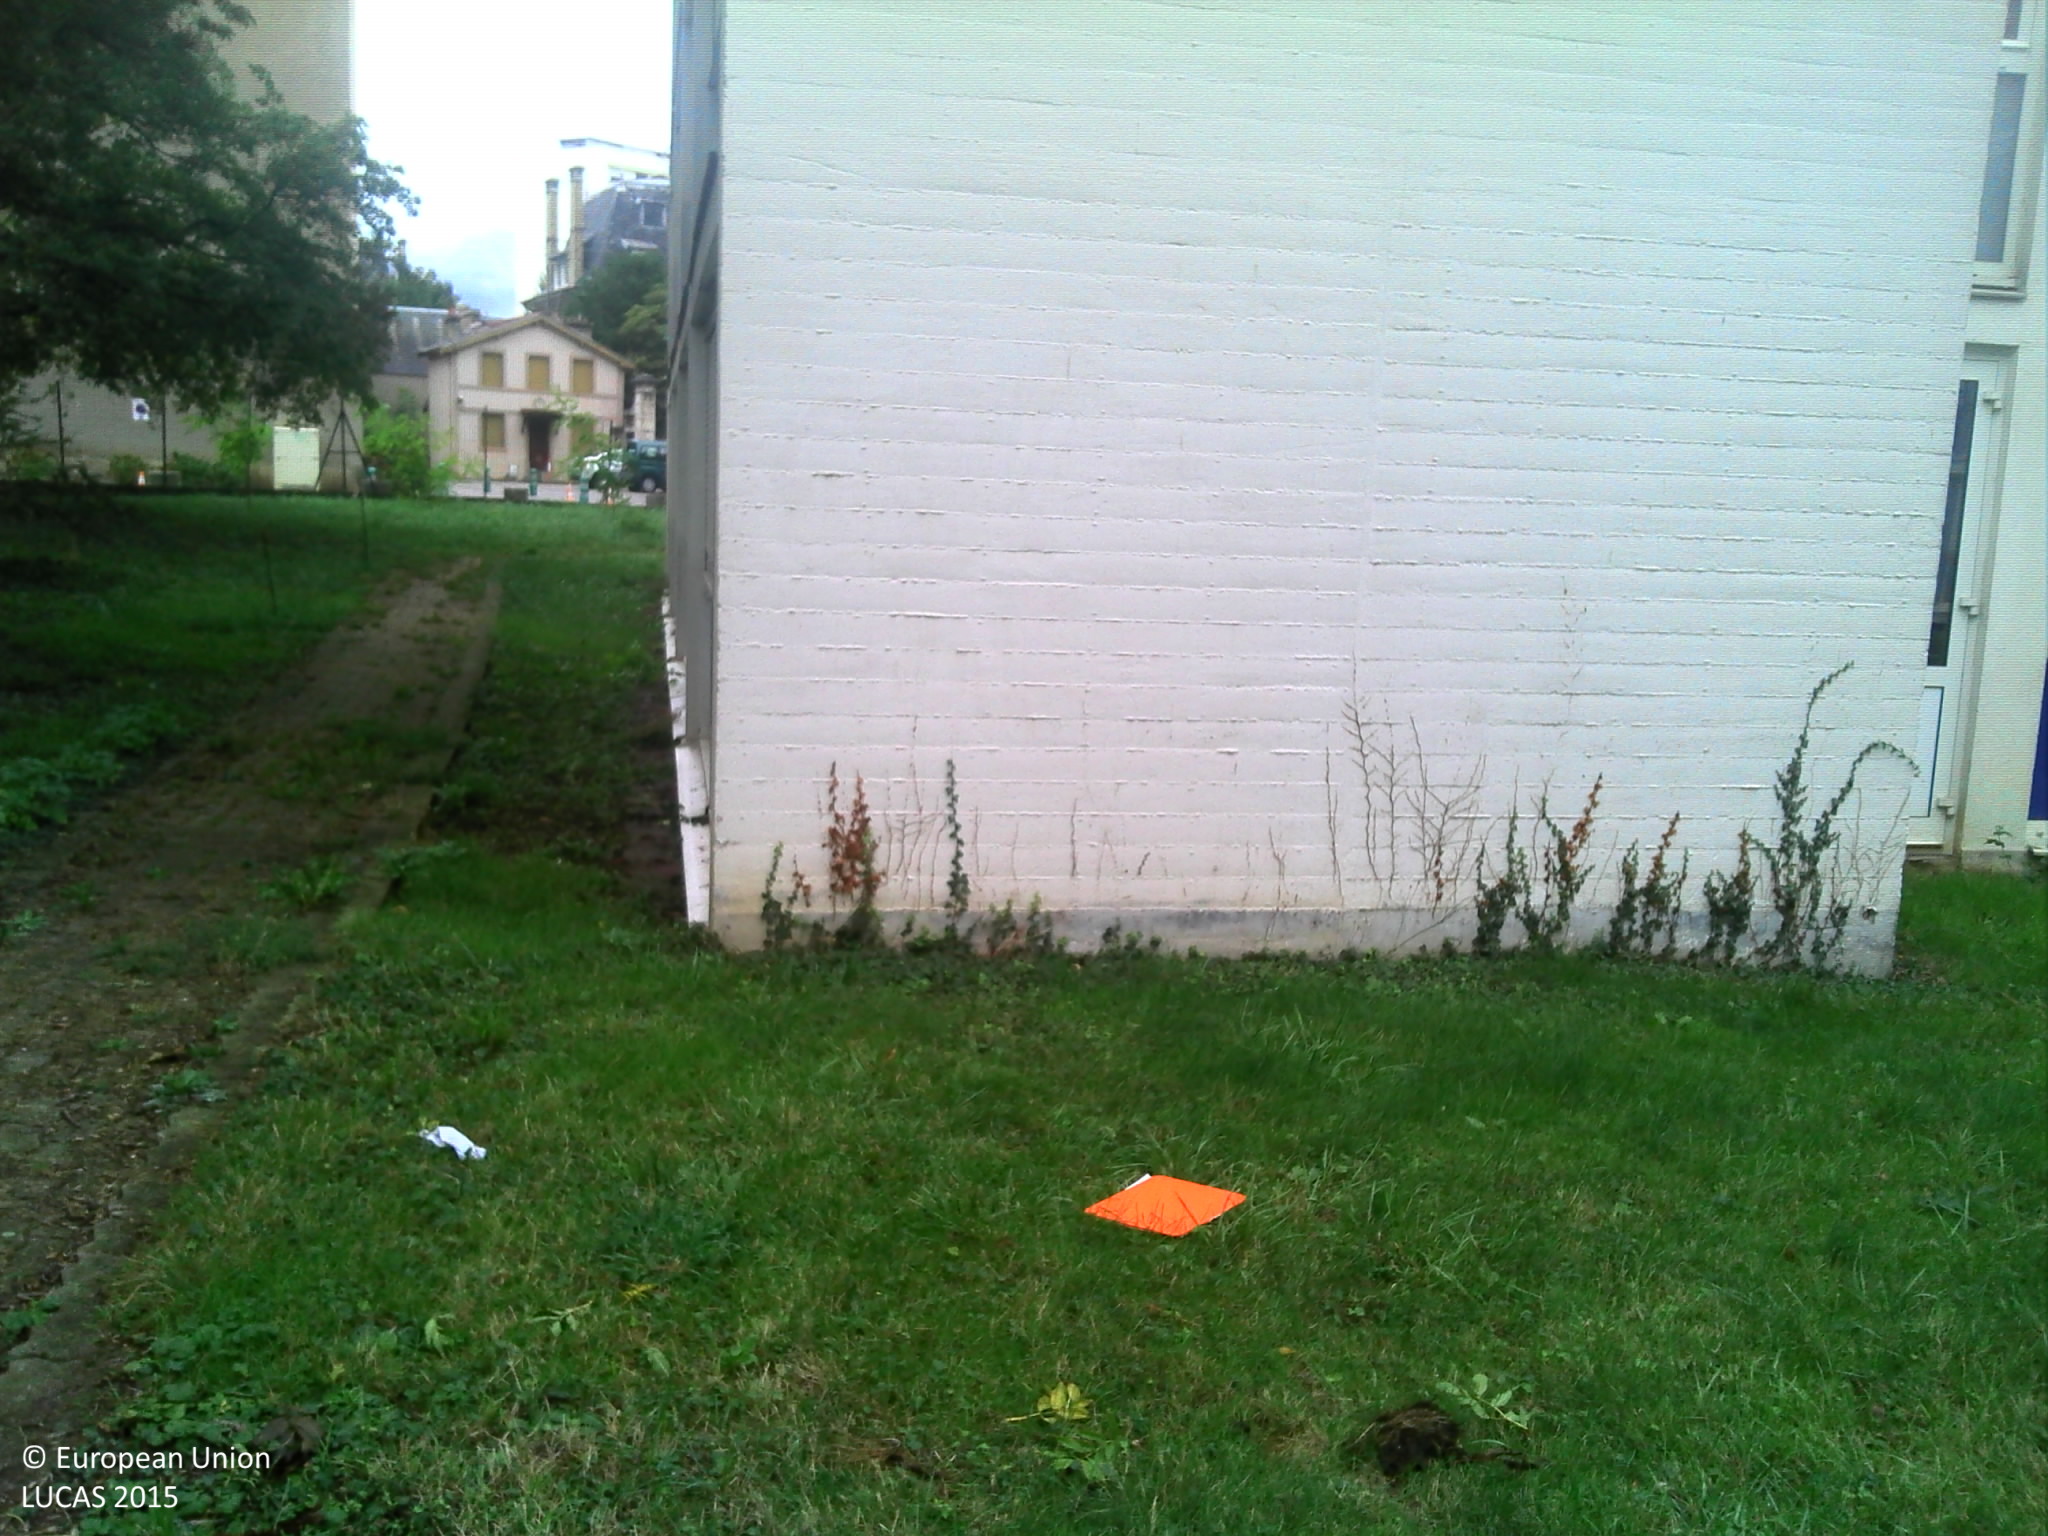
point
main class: Grassland
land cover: Grassland with sparse tree/shrub cover
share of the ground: > 75 %
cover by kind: herbaceous plants 85 %, consolidated bare surface 10 %, broadleaved forest trees 5 %
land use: Residential
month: September
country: FR
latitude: 48.6799
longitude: 6.1835
